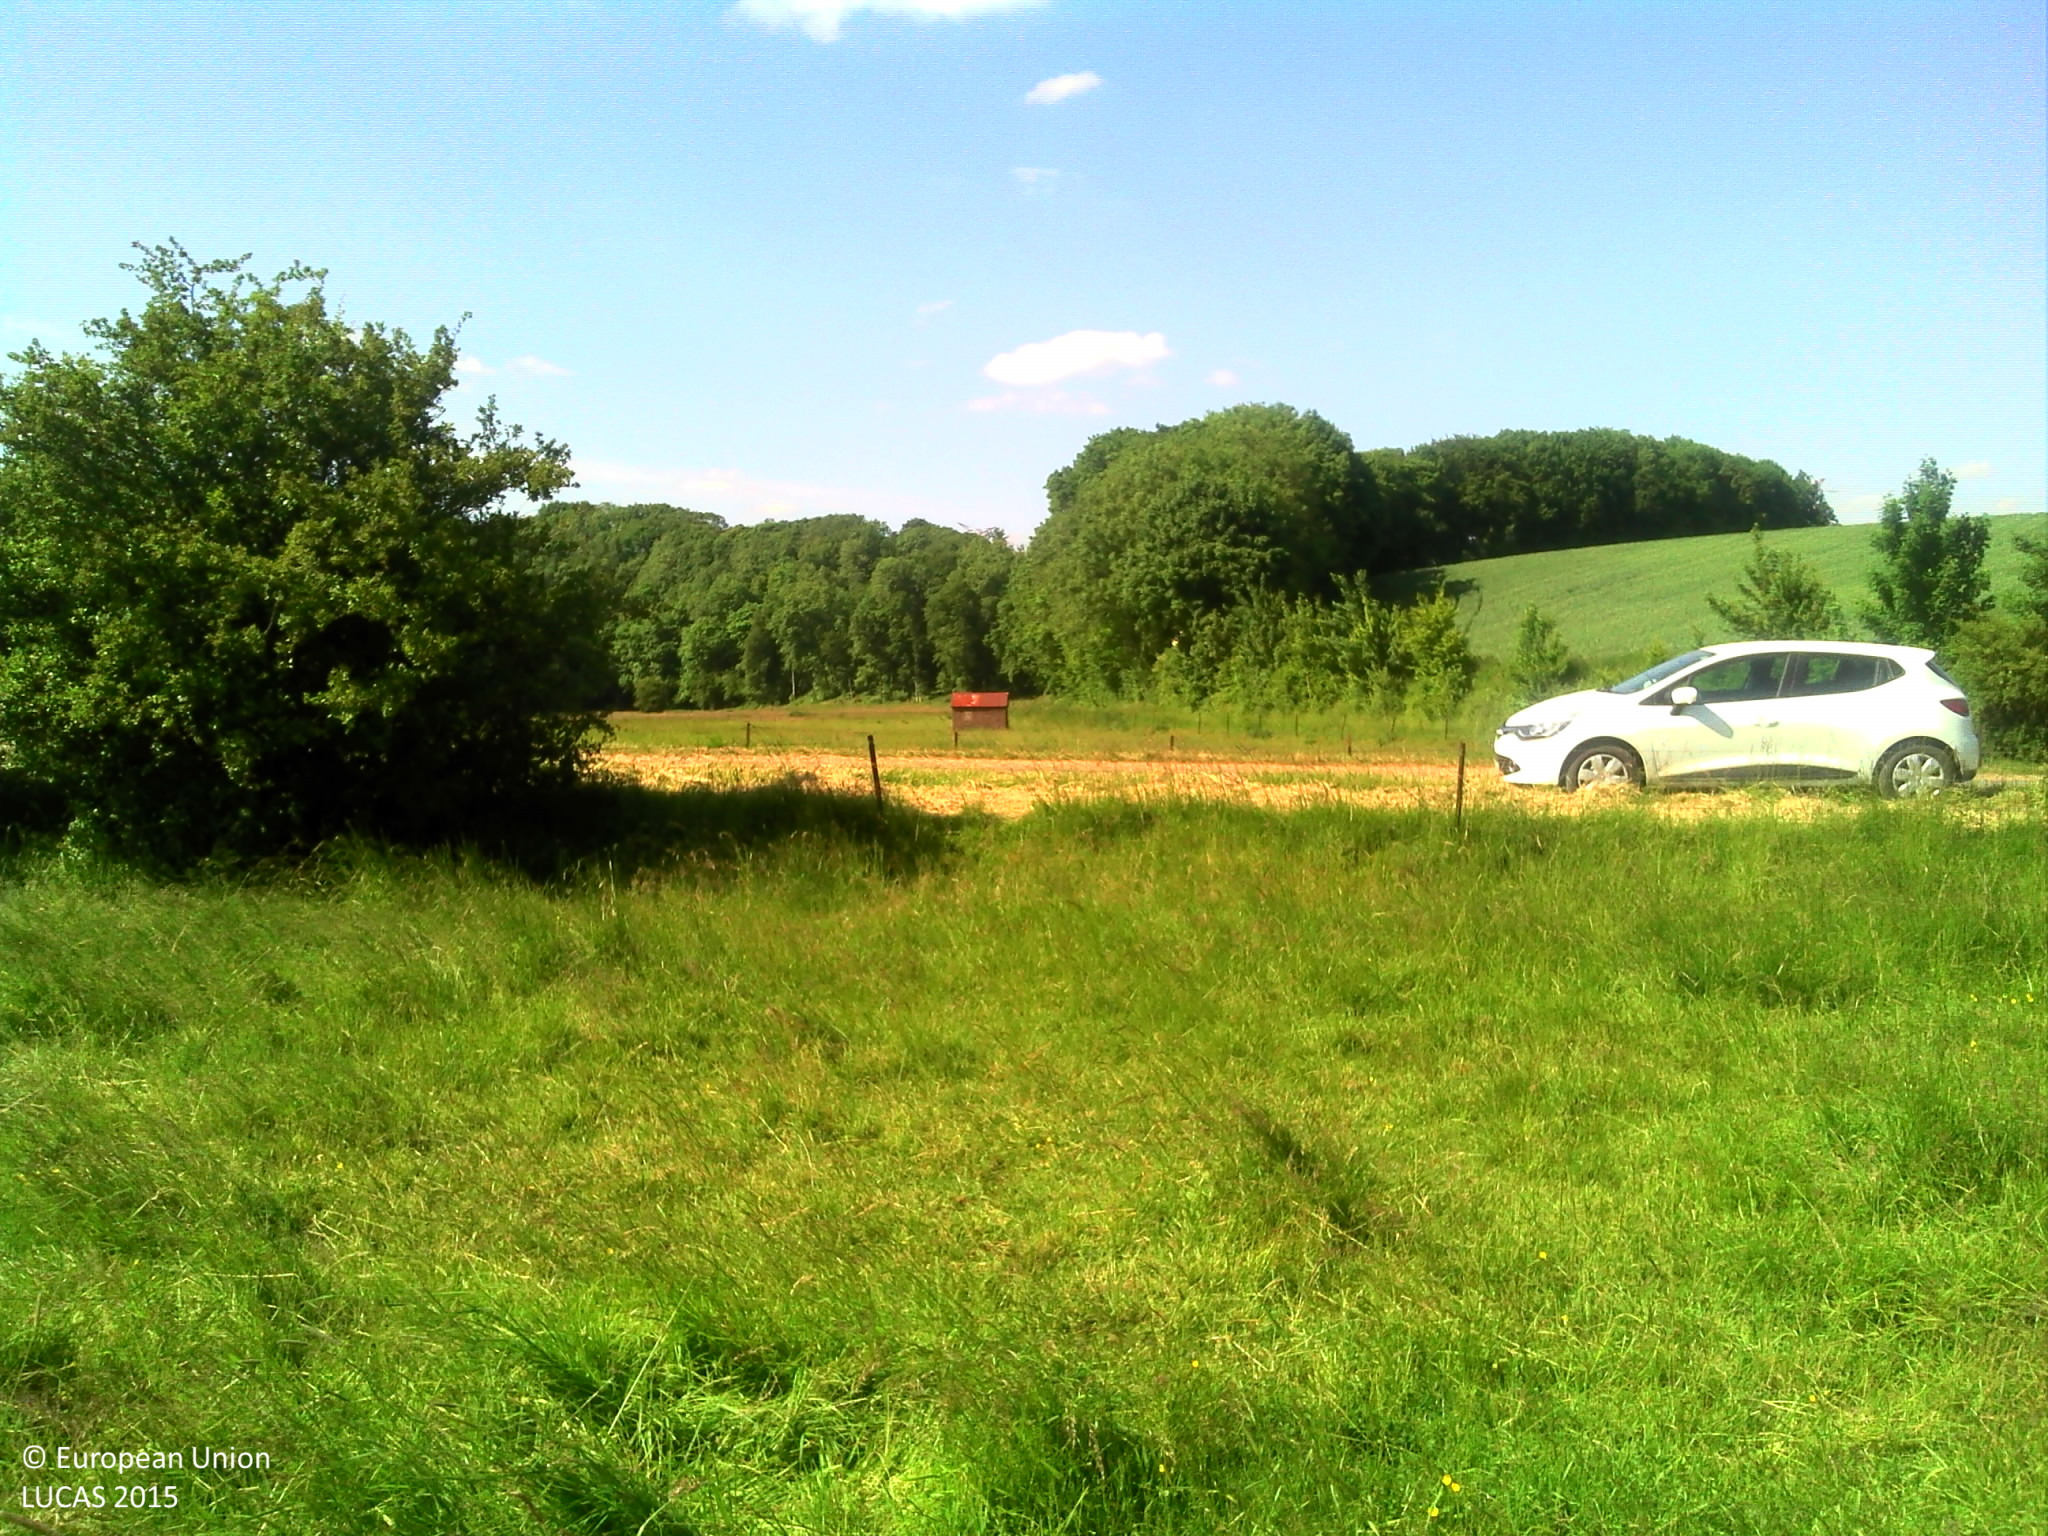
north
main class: Grassland
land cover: Grassland without tree/shrub cover
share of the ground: > 75 %
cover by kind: herbaceous plants 100 %
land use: Agriculture (excluding fallow land and kitchen gardens)
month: June
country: FR
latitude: 49.8697
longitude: 4.1095
